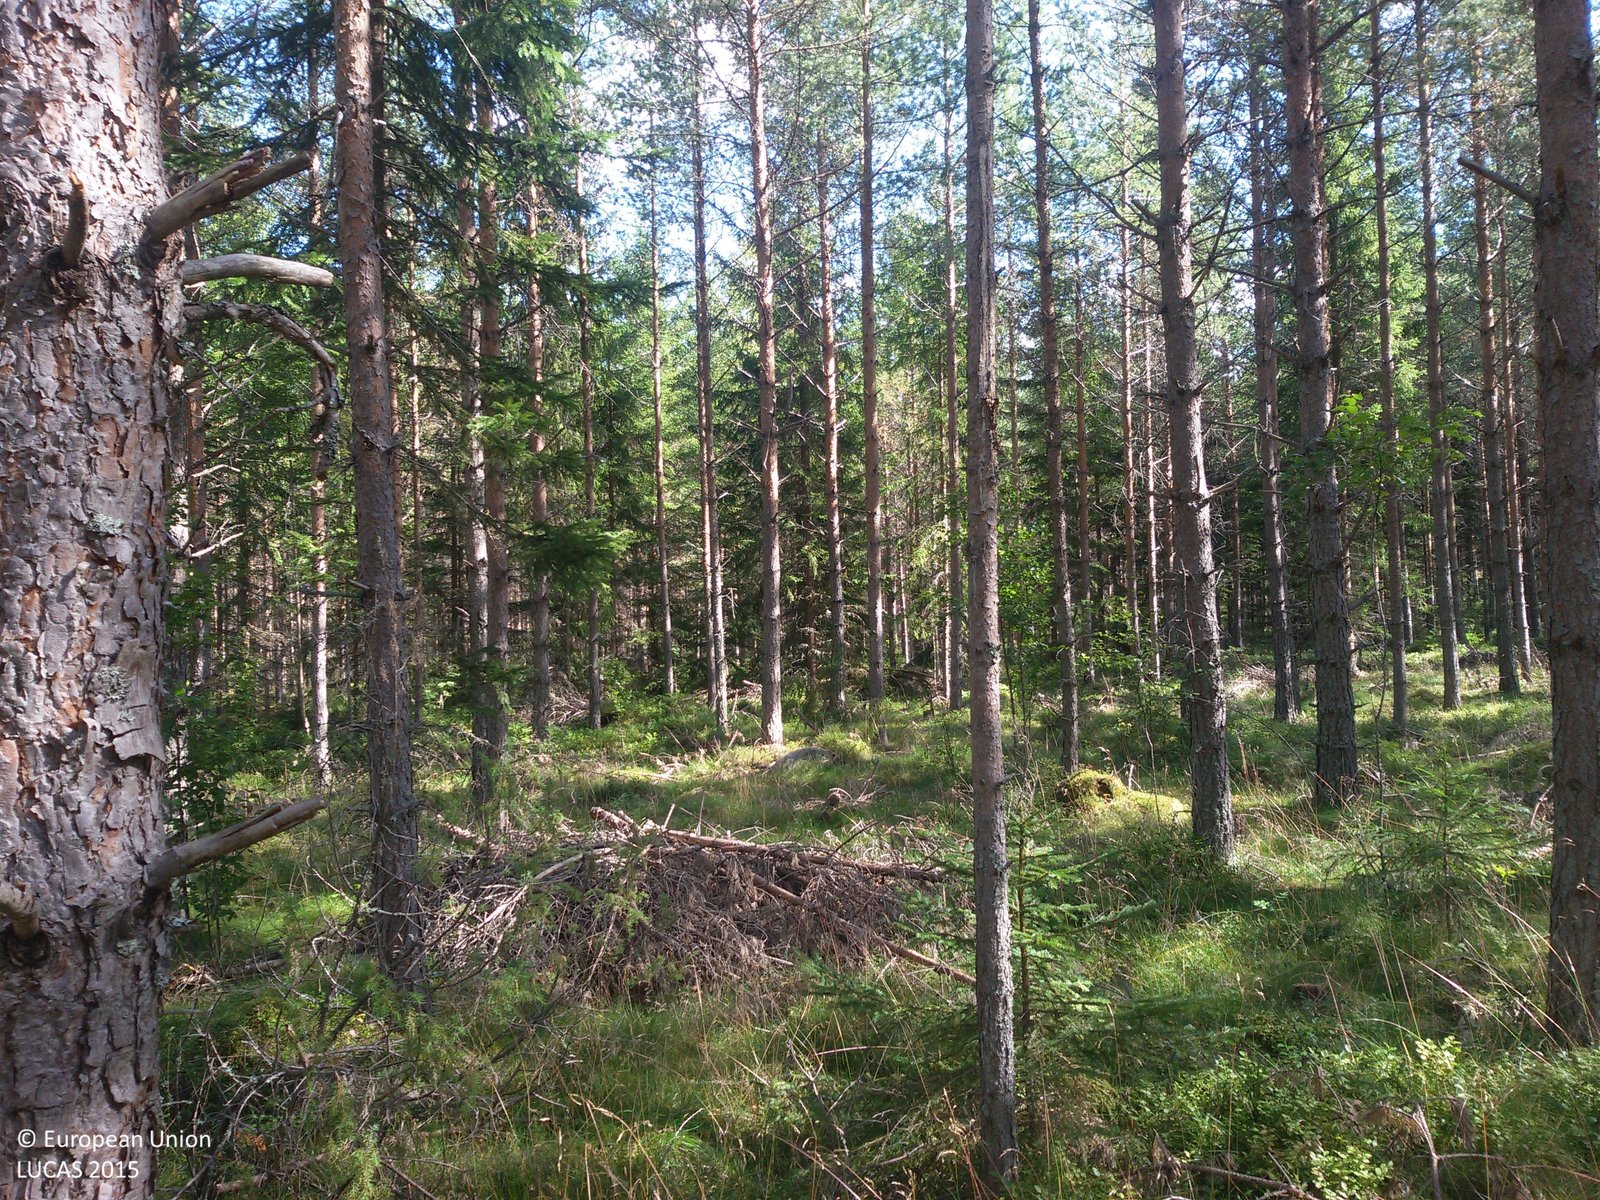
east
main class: Woodland
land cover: Pine dominated coniferous woodland
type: boreal forest
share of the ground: > 75 %
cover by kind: coniferous forest trees 80 %, herbaceous plants 15 %, lichens and mosses 5 %
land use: Forestry
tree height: > 5 m
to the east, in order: Pine dominated coniferous woodland; Ditches and canals; Pine dominated coniferous woodland; Ditches and canals; Pine dominated coniferous woodland
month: August
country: SE
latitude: 60.6443
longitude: 15.6744
